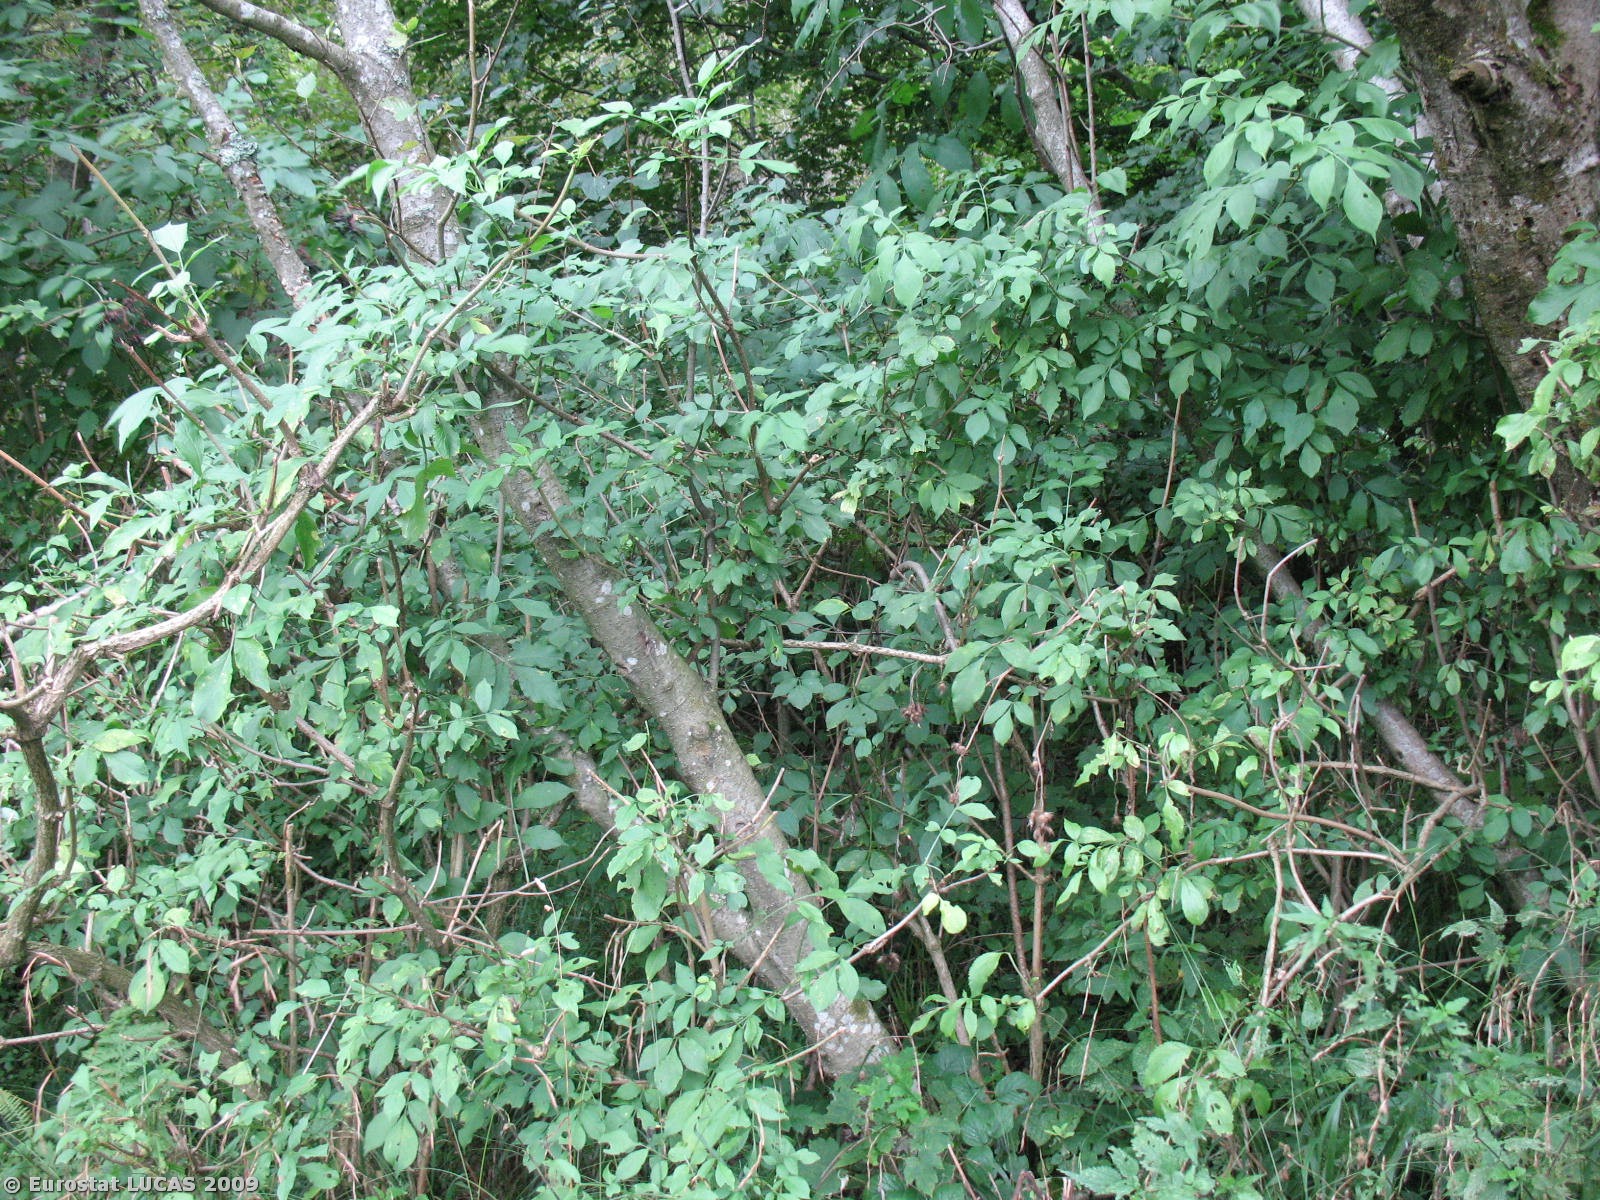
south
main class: Woodland
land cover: Broadleaved woodland
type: mesophytic deciduous forest
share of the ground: > 75 %
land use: Nature reserves
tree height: > 5 m
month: September
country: PL
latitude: 49.2273
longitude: 22.4349
